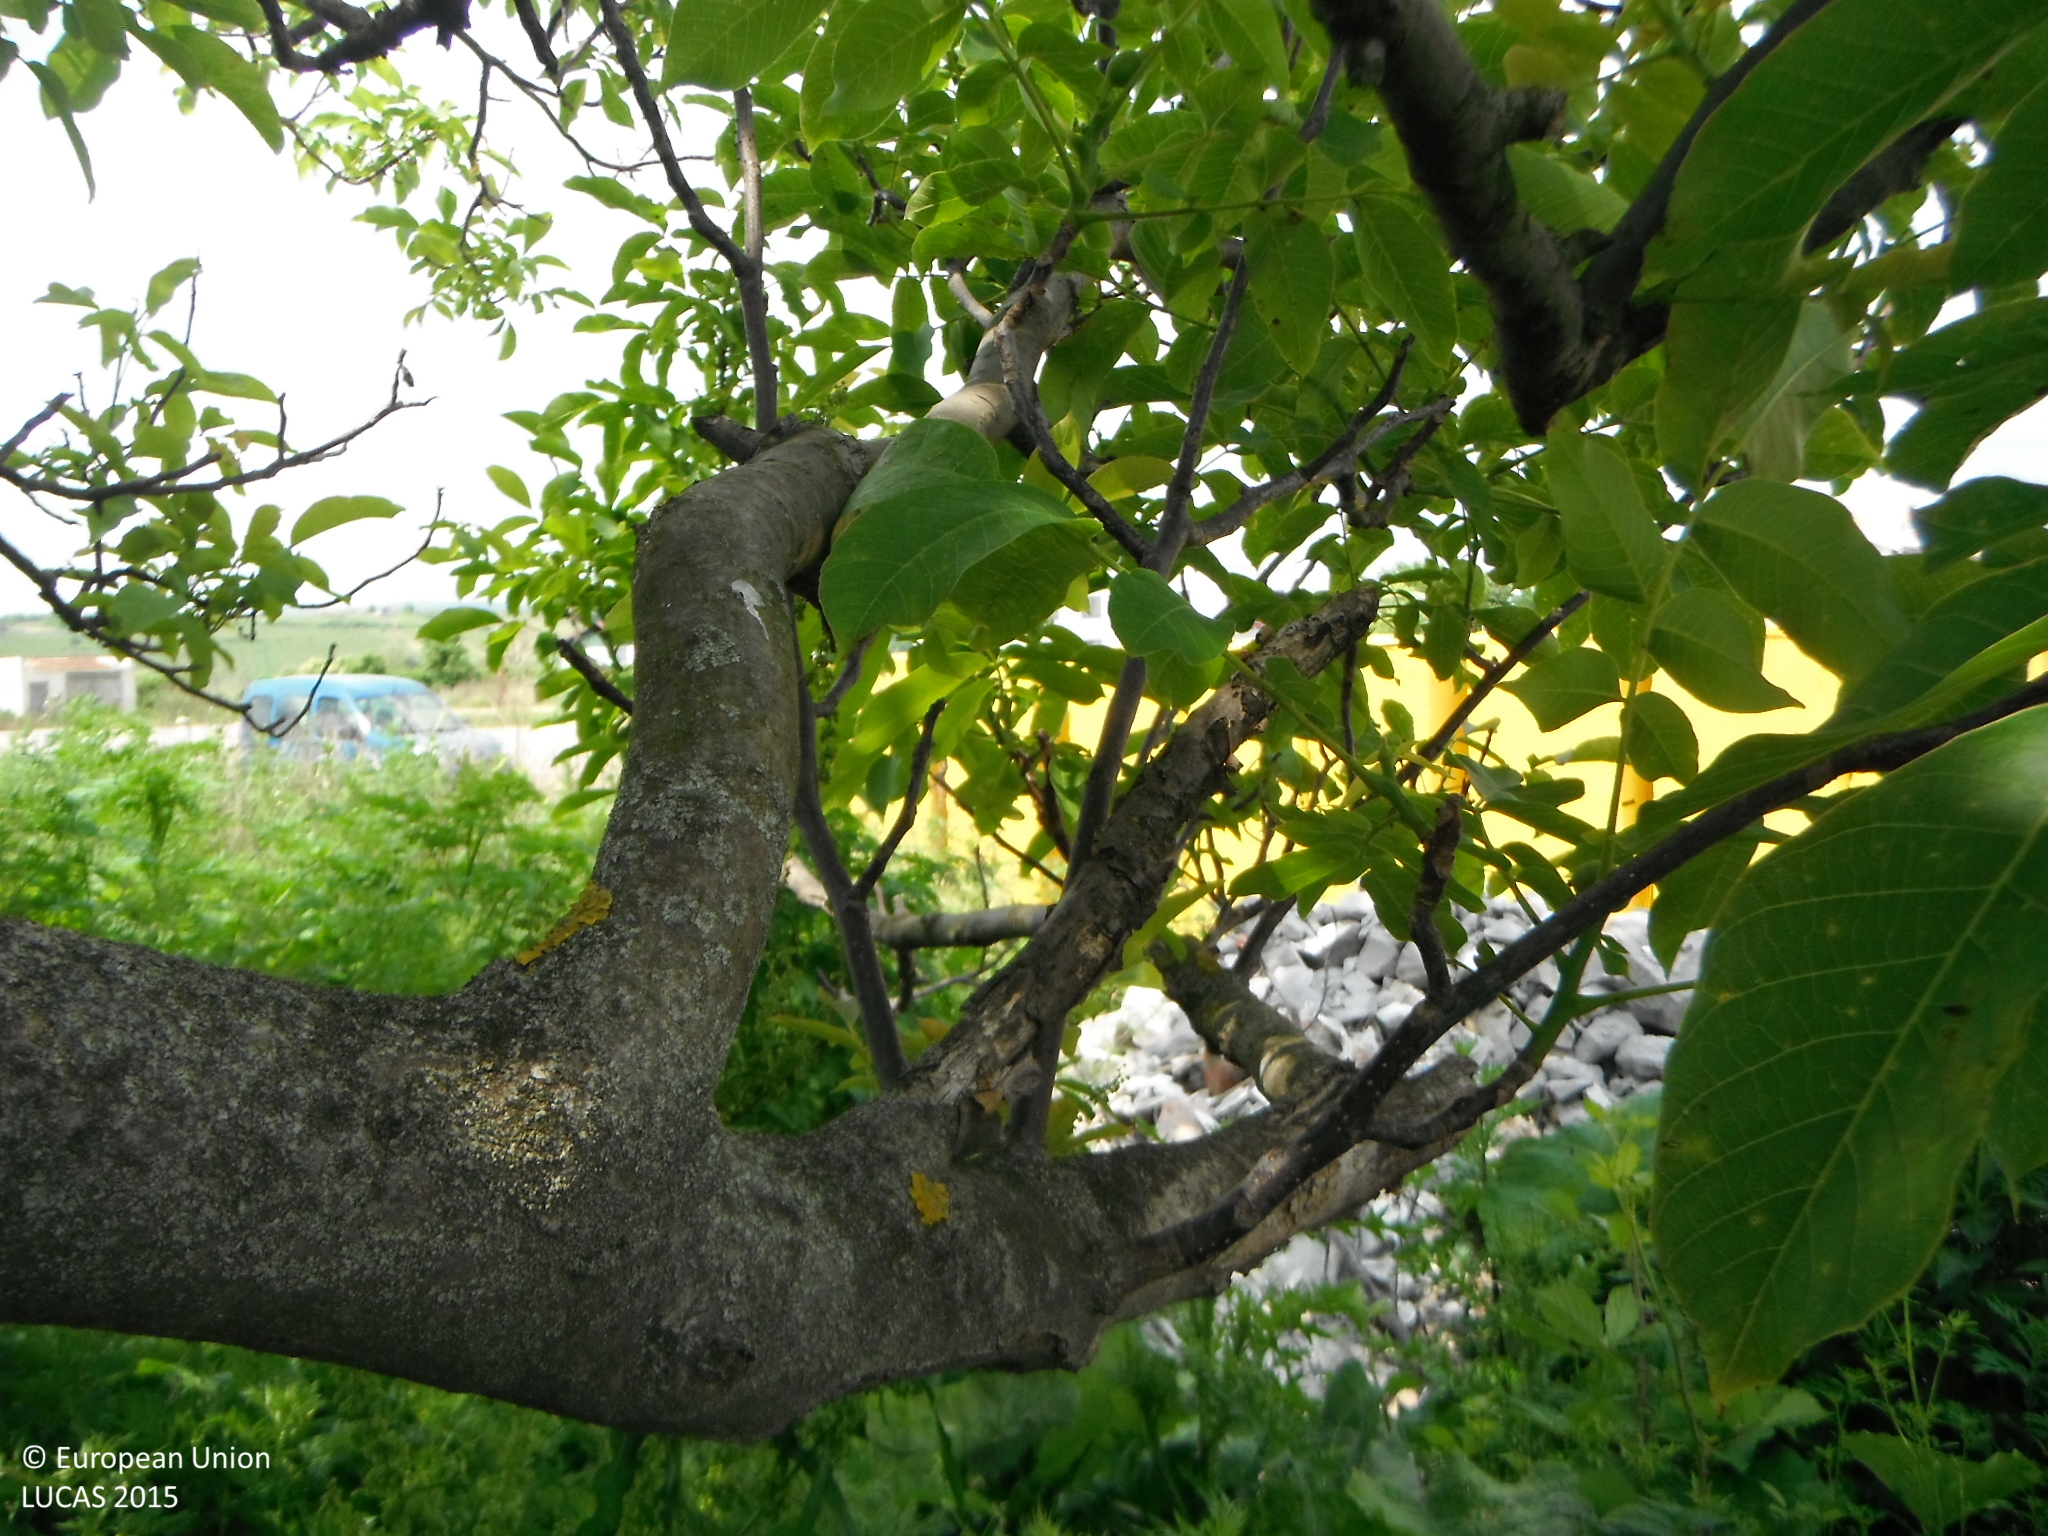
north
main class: Woodland
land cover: Broadleaved woodland
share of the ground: > 75 %
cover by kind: broadleaved forest trees 90 %, shrubs 5 %, herbaceous plants 5 %
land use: Abandoned areas
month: June
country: SK
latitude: 48.4086
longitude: 18.4053
